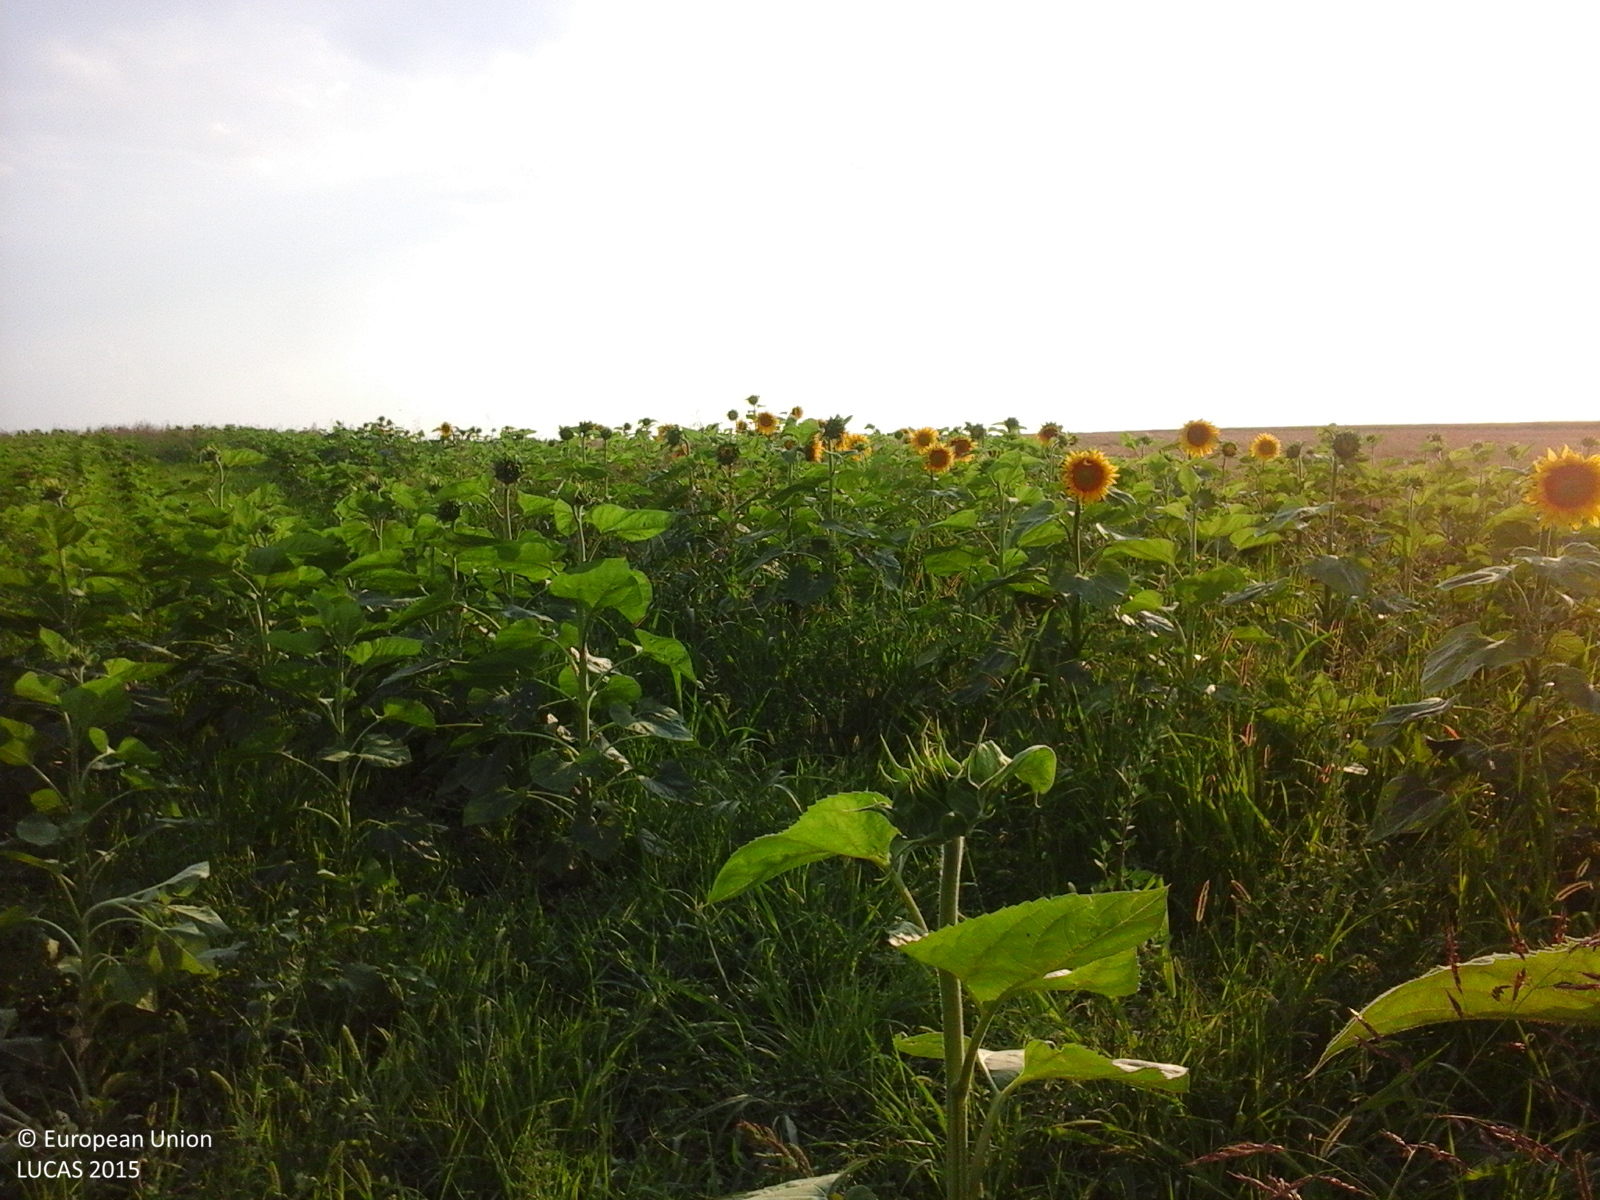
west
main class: Cropland
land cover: Sunflower
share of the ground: > 75 %
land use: Agriculture (excluding fallow land and kitchen gardens)
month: July
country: RO
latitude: 43.9237
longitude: 25.4162
